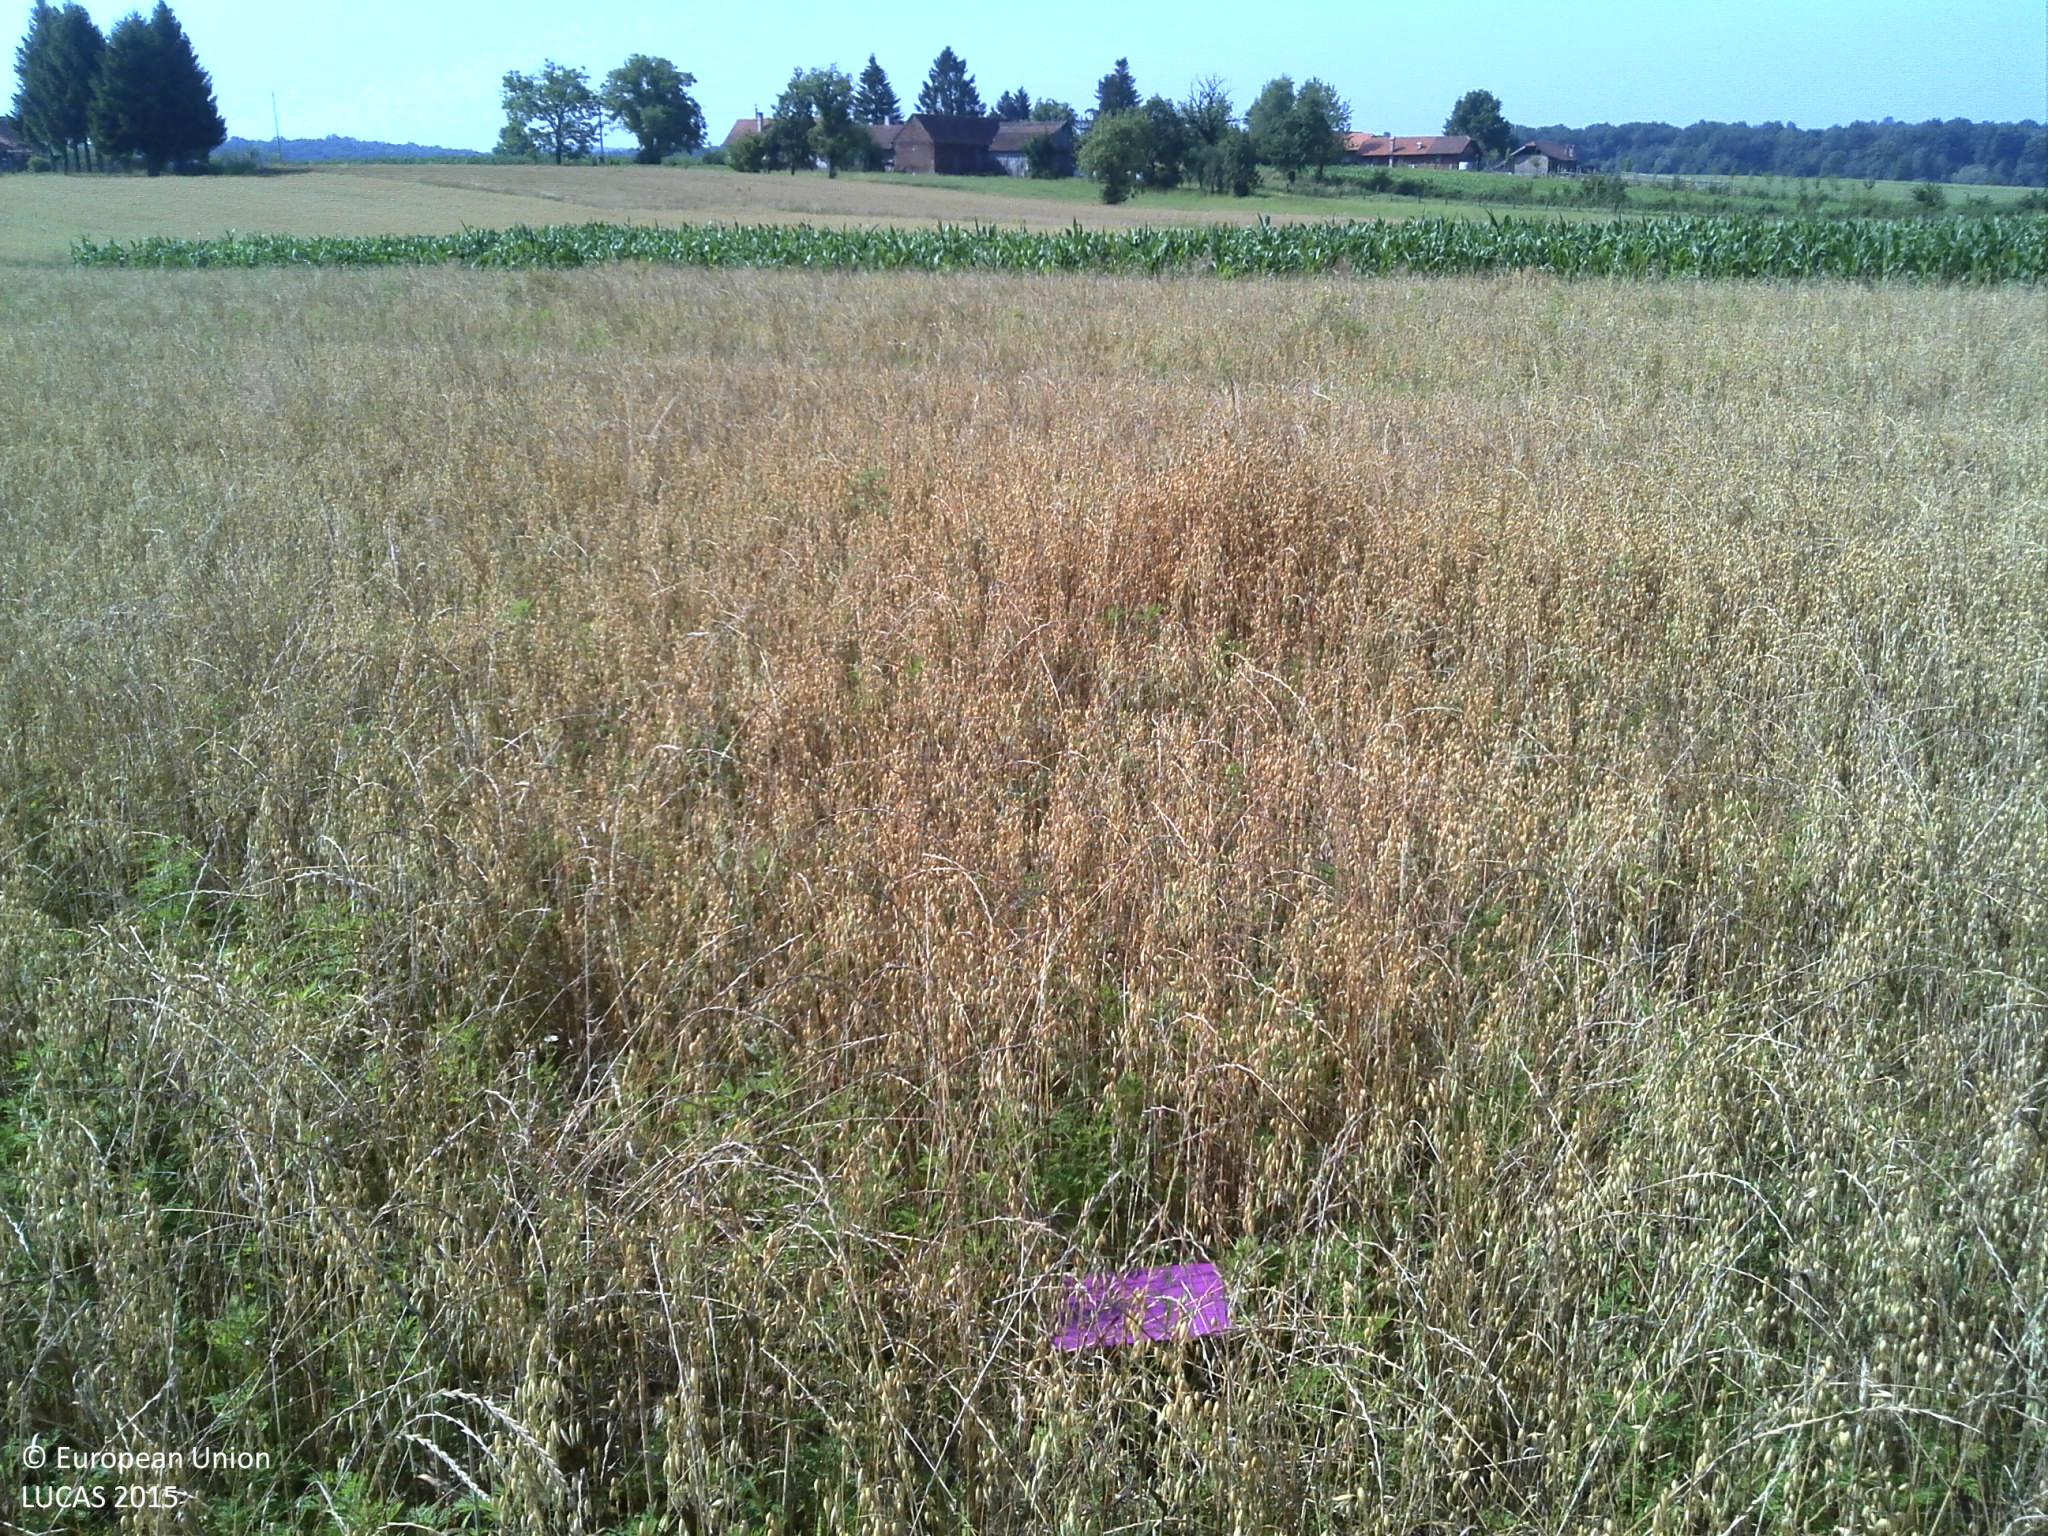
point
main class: Cropland
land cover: Oats
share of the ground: > 75 %
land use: Agriculture (excluding fallow land and kitchen gardens)
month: July
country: HR
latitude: 45.7712
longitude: 16.5447
